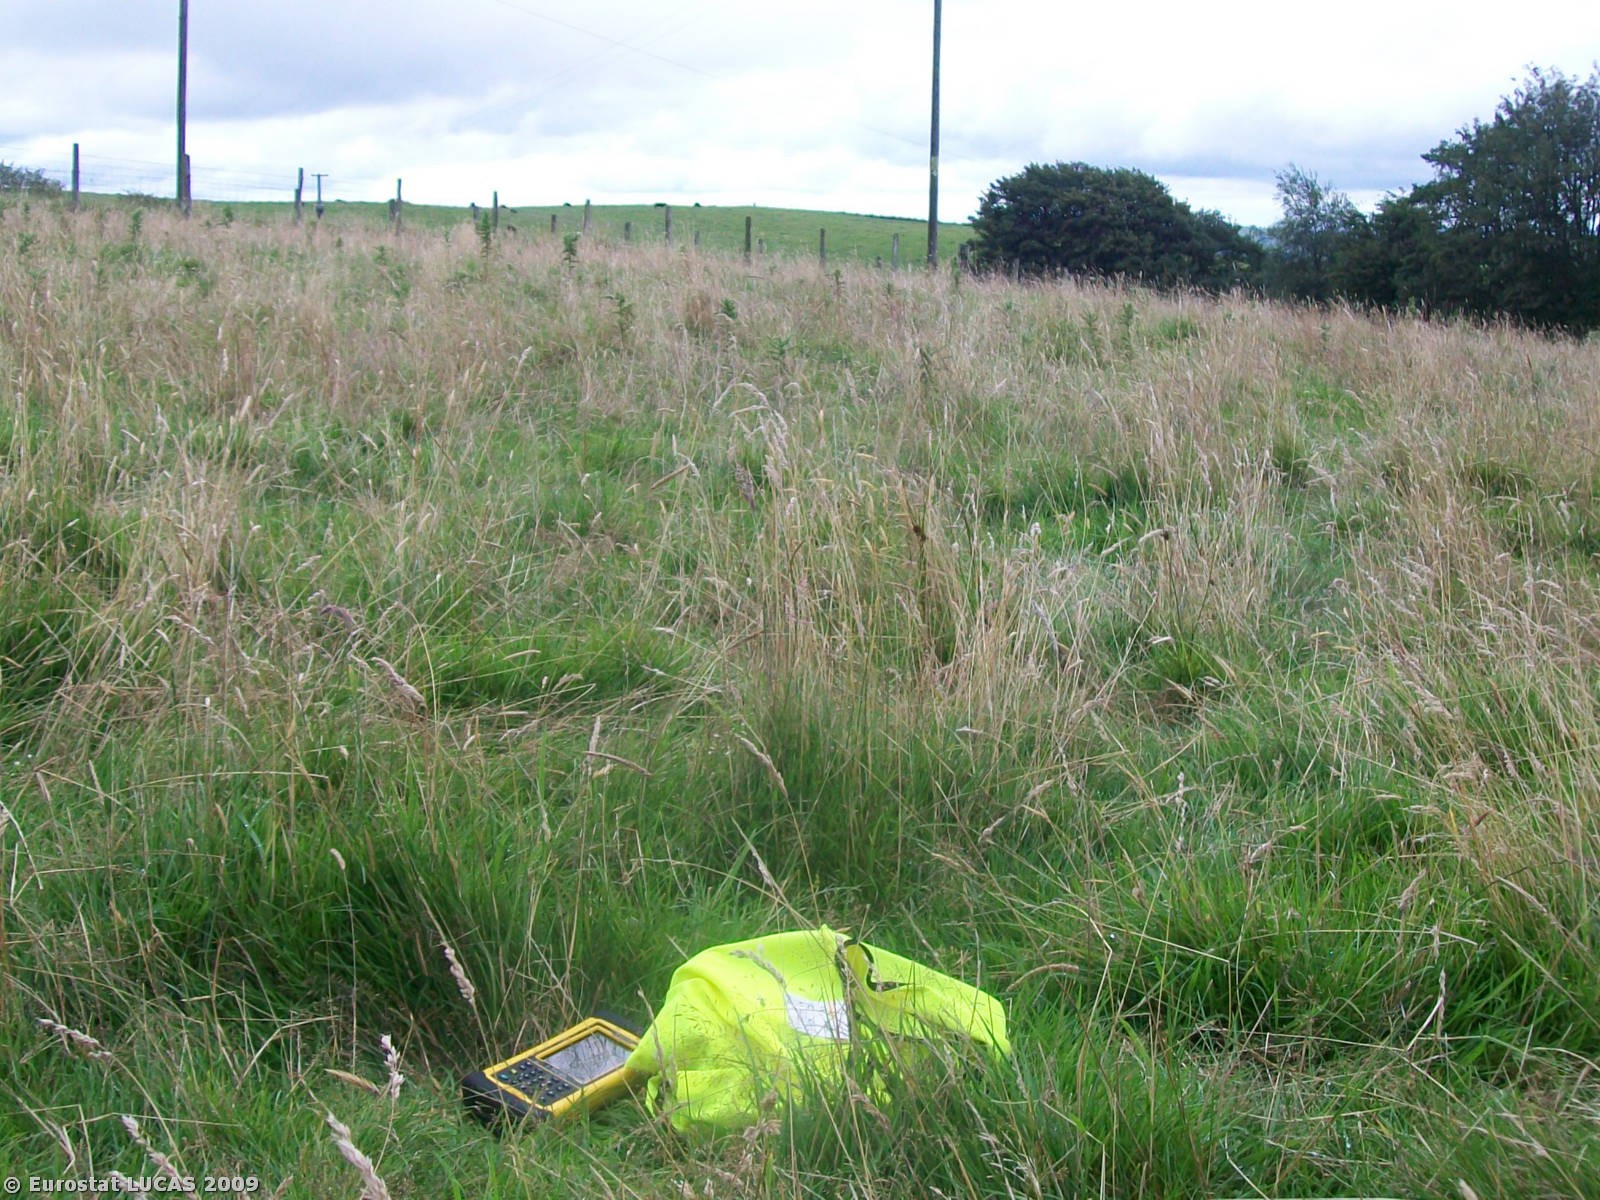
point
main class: Grassland
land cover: Grassland without tree/shrub cover
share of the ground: > 75 %
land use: Agriculture (excluding fallow land and kitchen gardens)
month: August
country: GB
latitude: 52.7616
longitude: -3.4047
